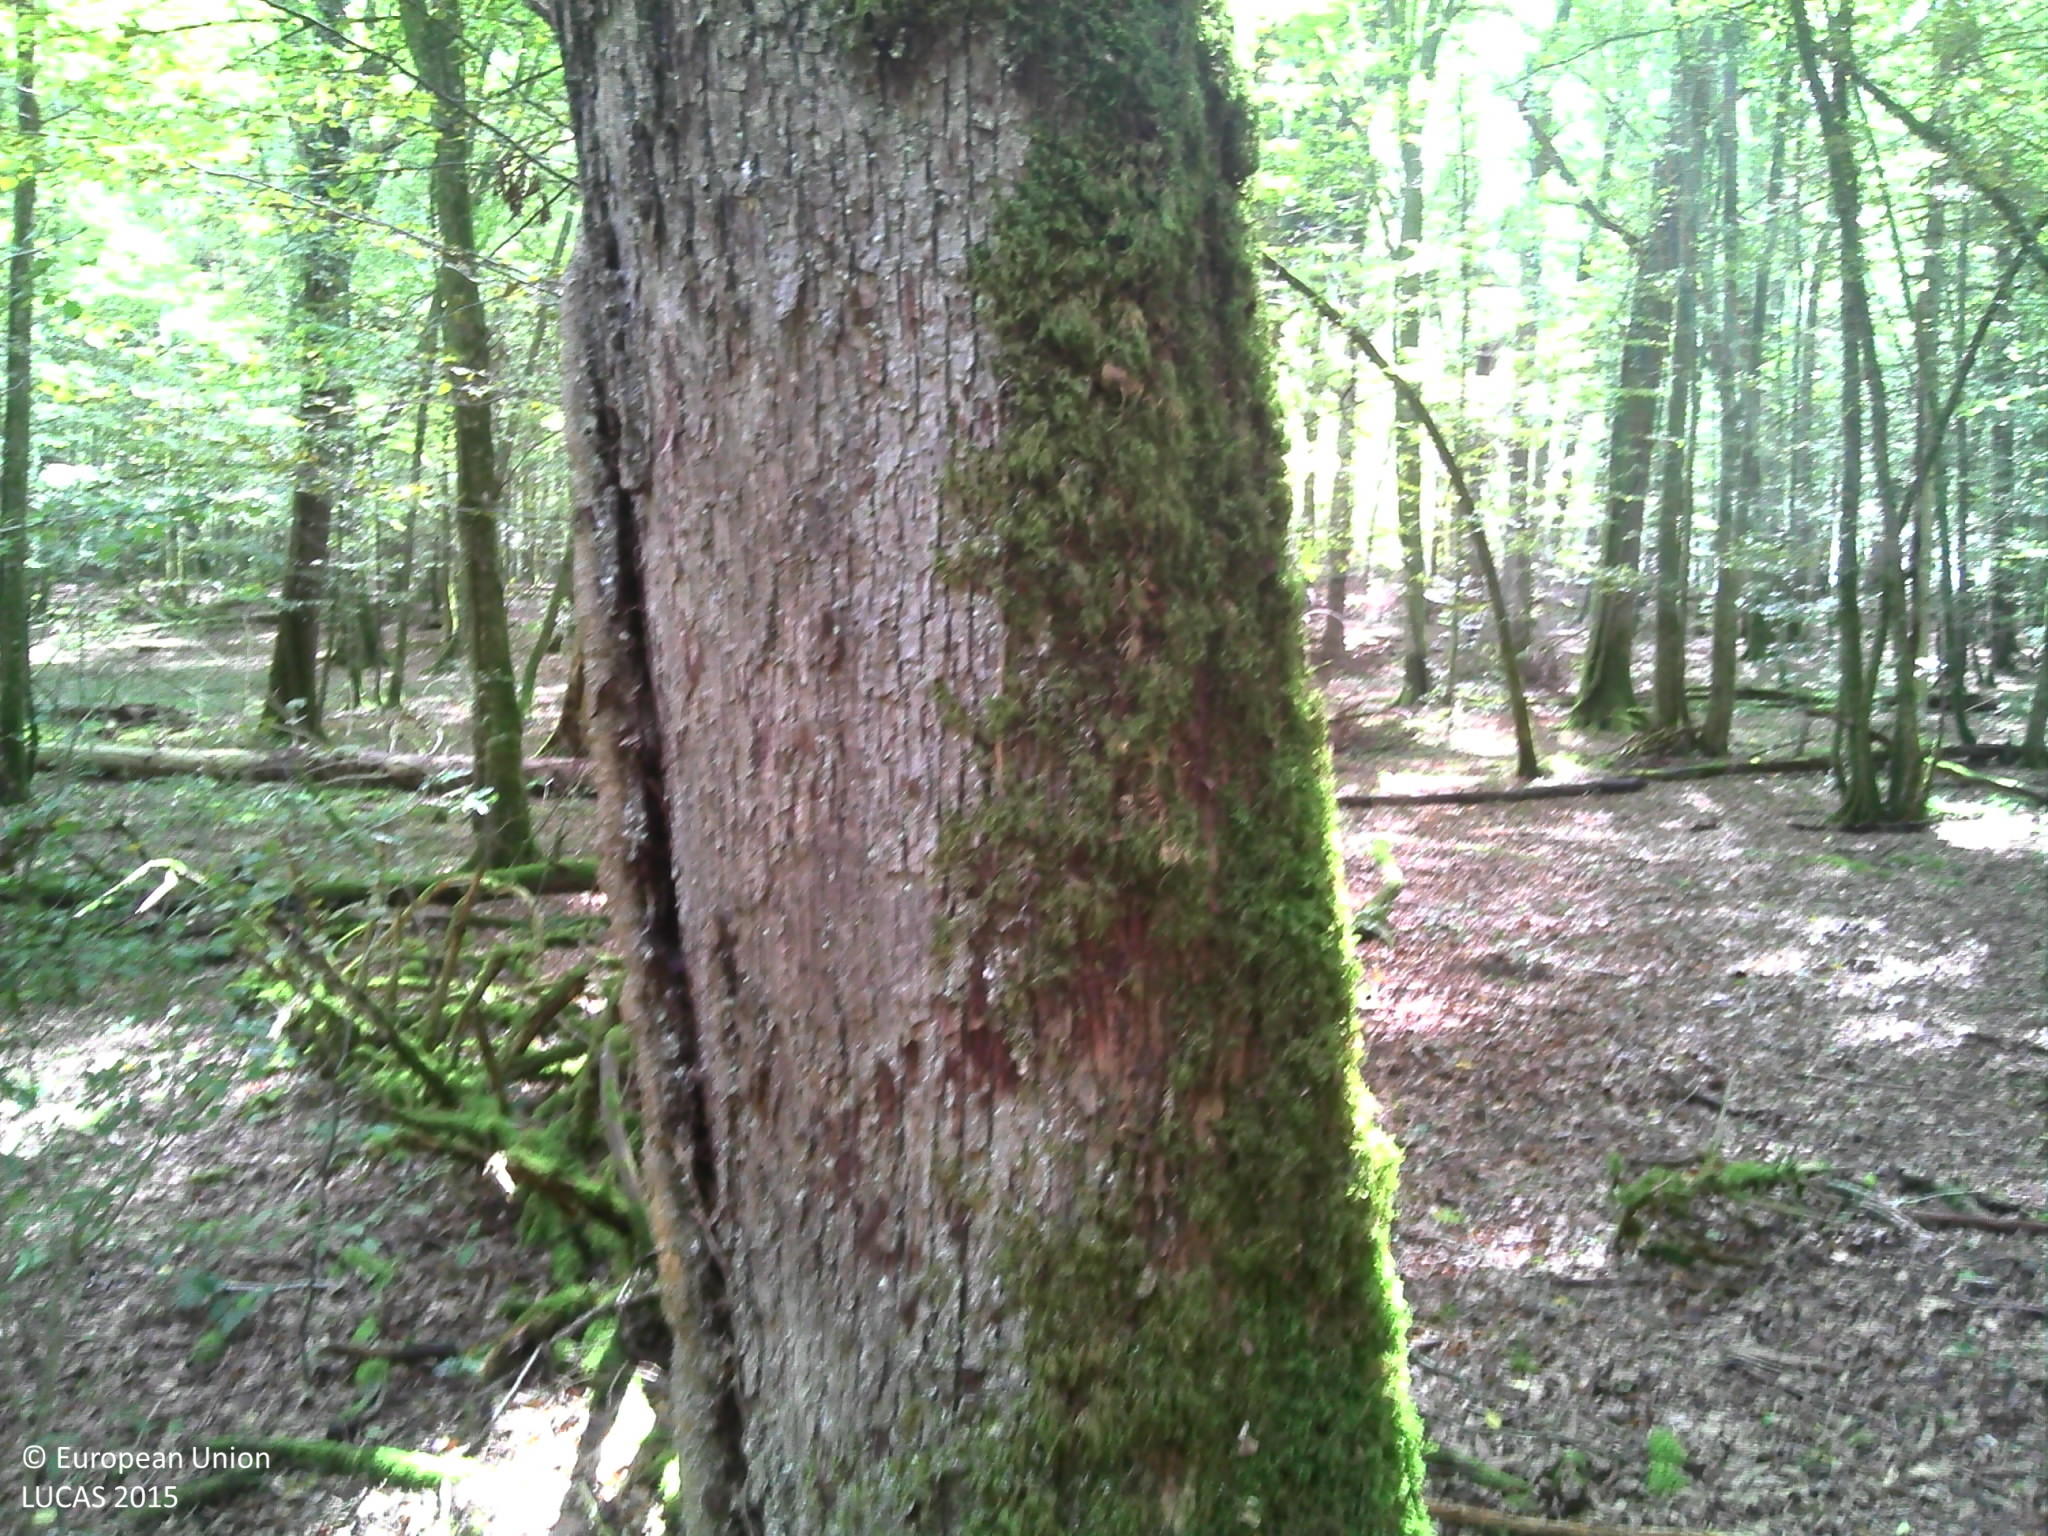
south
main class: Woodland
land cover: Broadleaved woodland
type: mesophytic deciduous forest
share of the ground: > 75 %
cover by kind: broadleaved forest trees 90 %, herbaceous plants 5 %, lichens and mosses 5 %
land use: Forestry
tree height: > 5 m
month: September
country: FR
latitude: 48.0012
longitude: 4.2476
